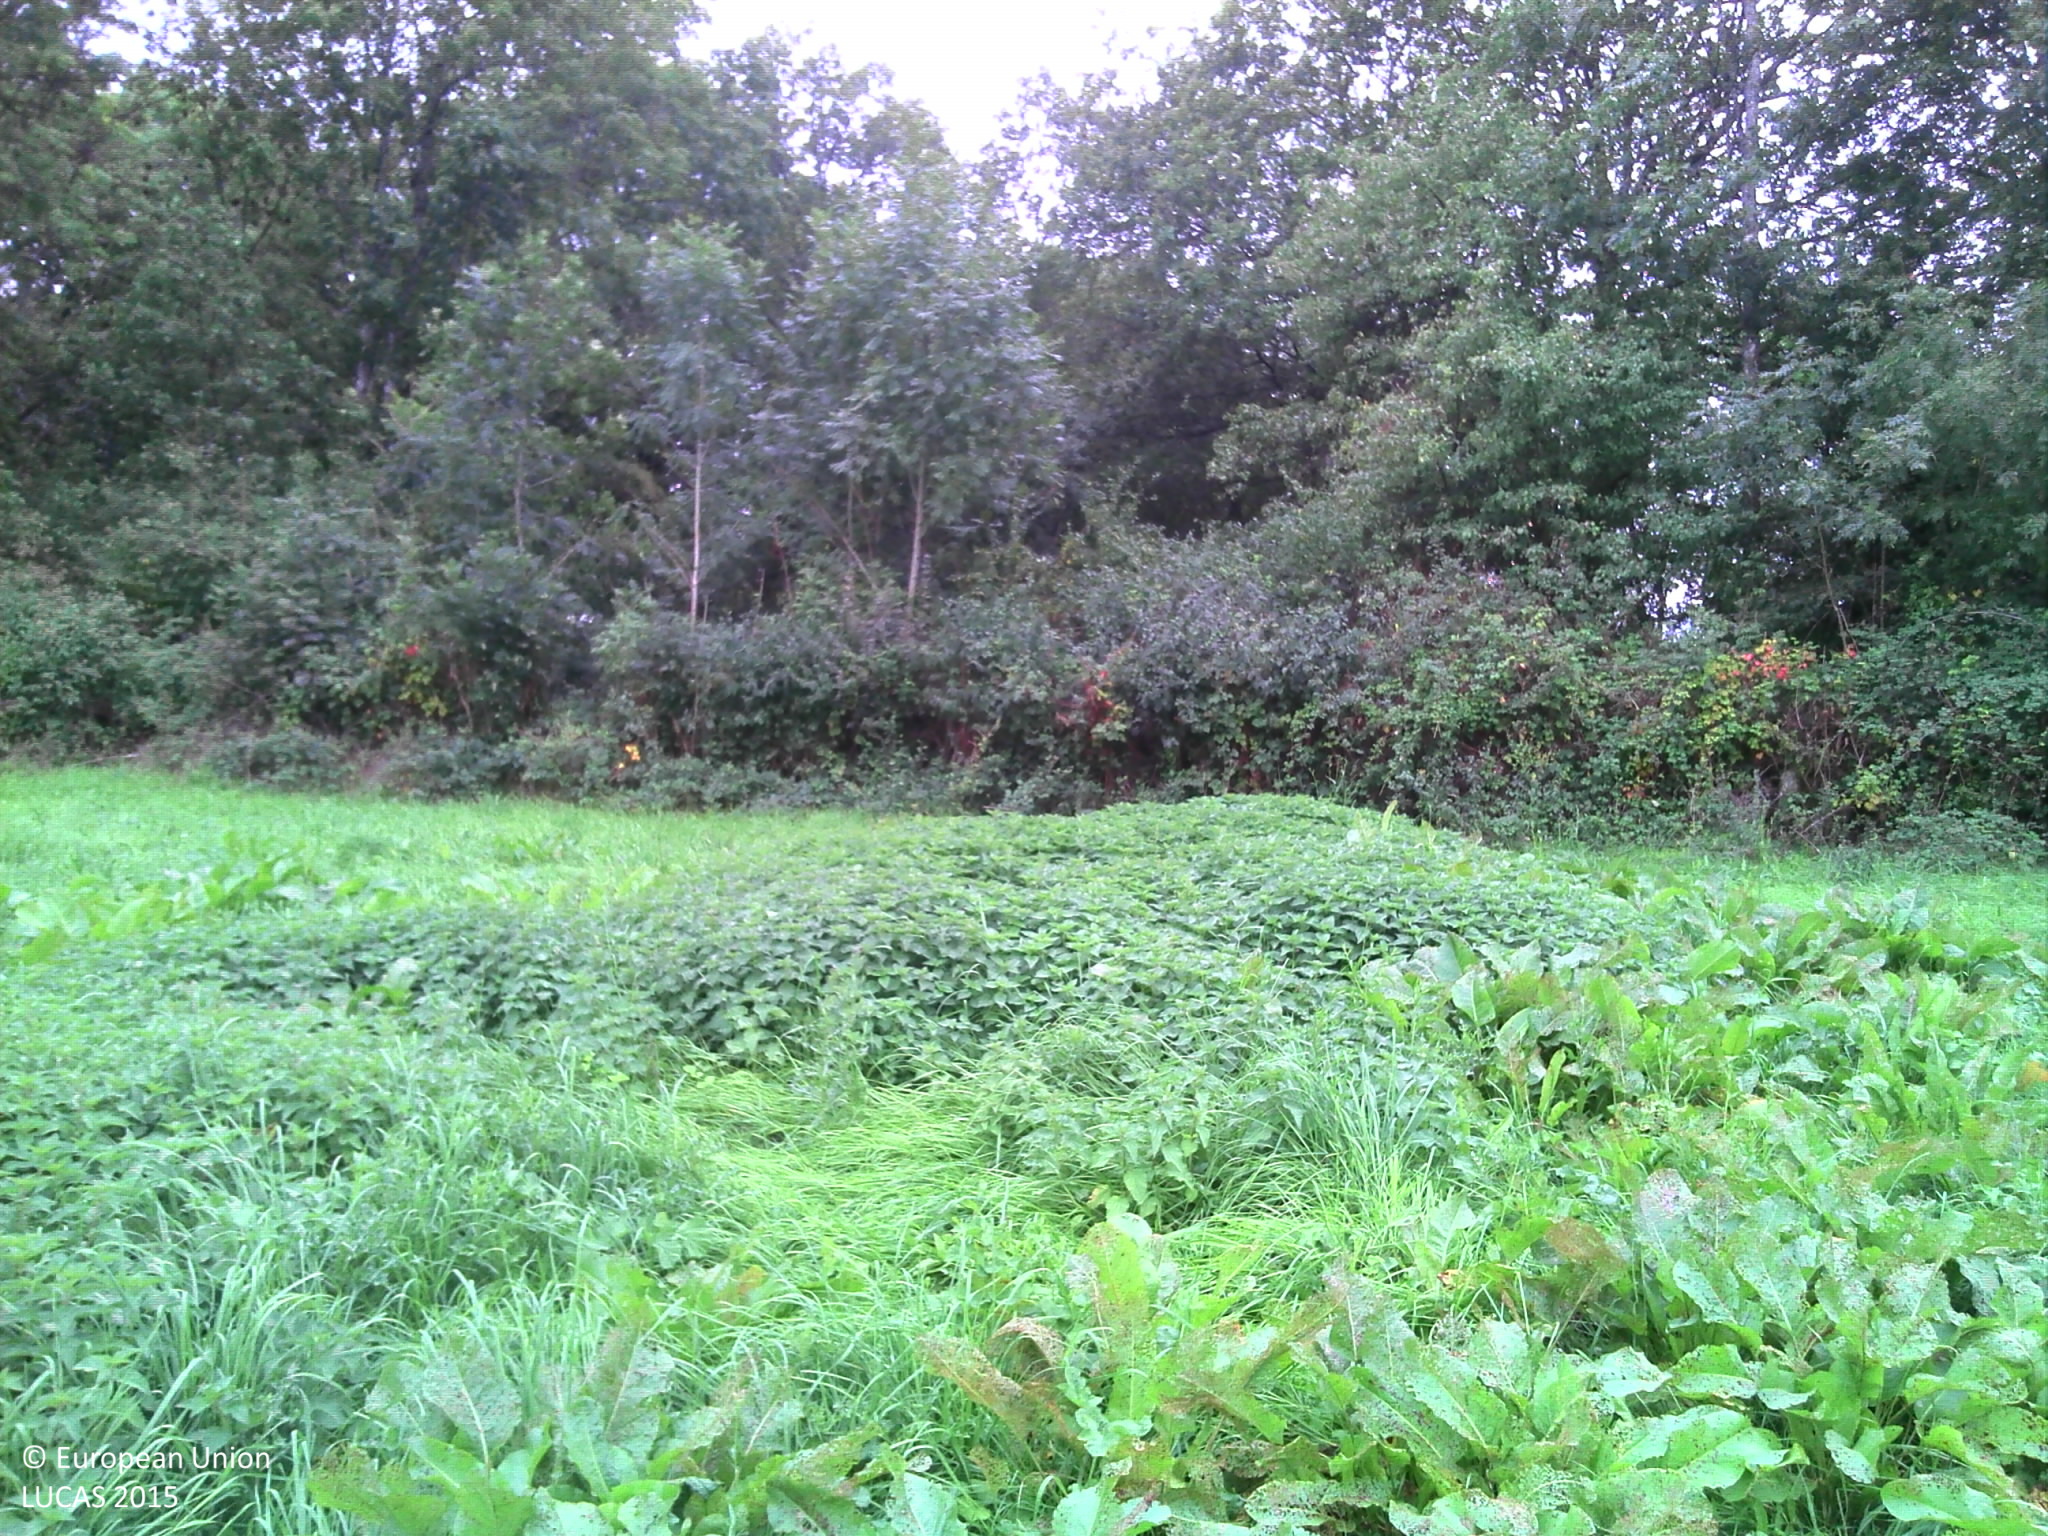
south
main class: Grassland
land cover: Grassland without tree/shrub cover
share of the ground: > 75 %
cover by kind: herbaceous plants 100 %
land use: Agriculture (excluding fallow land and kitchen gardens)
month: September
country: FR
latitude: 47.0724
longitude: 4.4294
